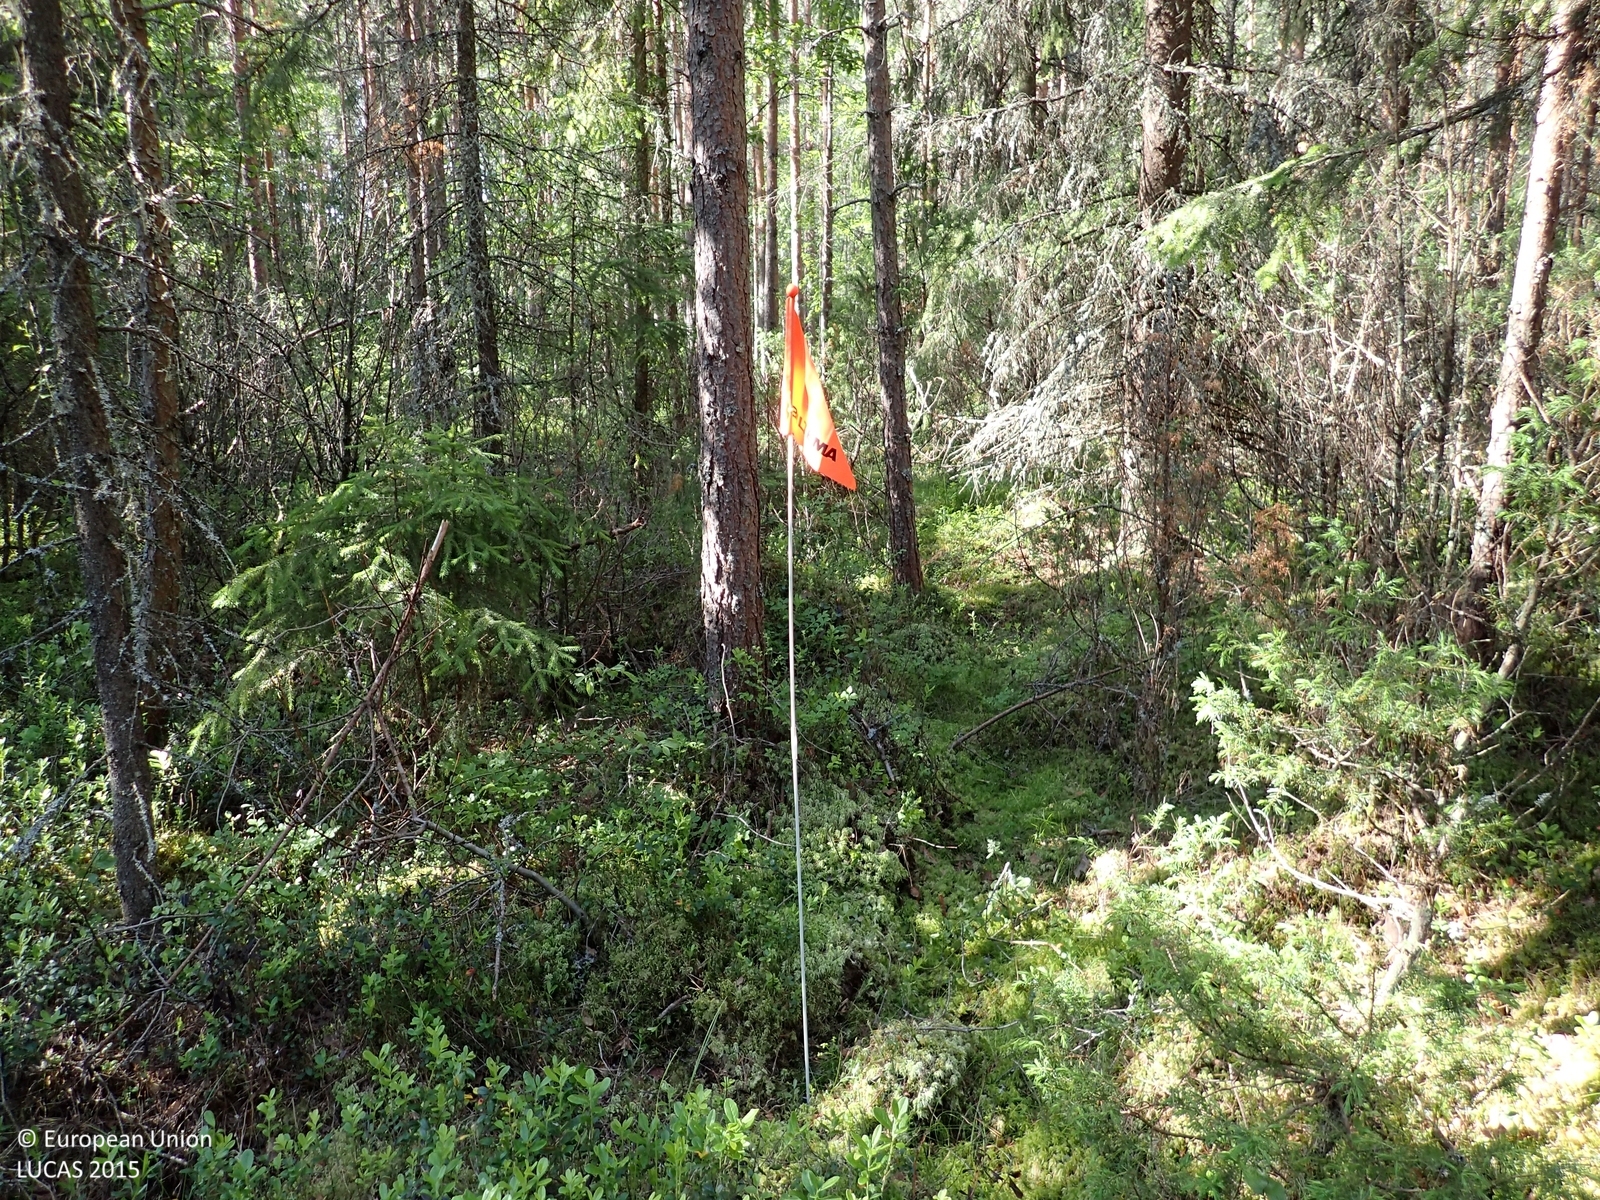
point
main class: Woodland
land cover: Other coniferous woodland
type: boreal forest
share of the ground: 50 - 75 %
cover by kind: coniferous forest trees 60 %, shrubs 35 %, lichens and mosses 5 %
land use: Forestry
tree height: > 5 m
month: July
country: FI
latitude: 62.7106
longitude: 21.5971
